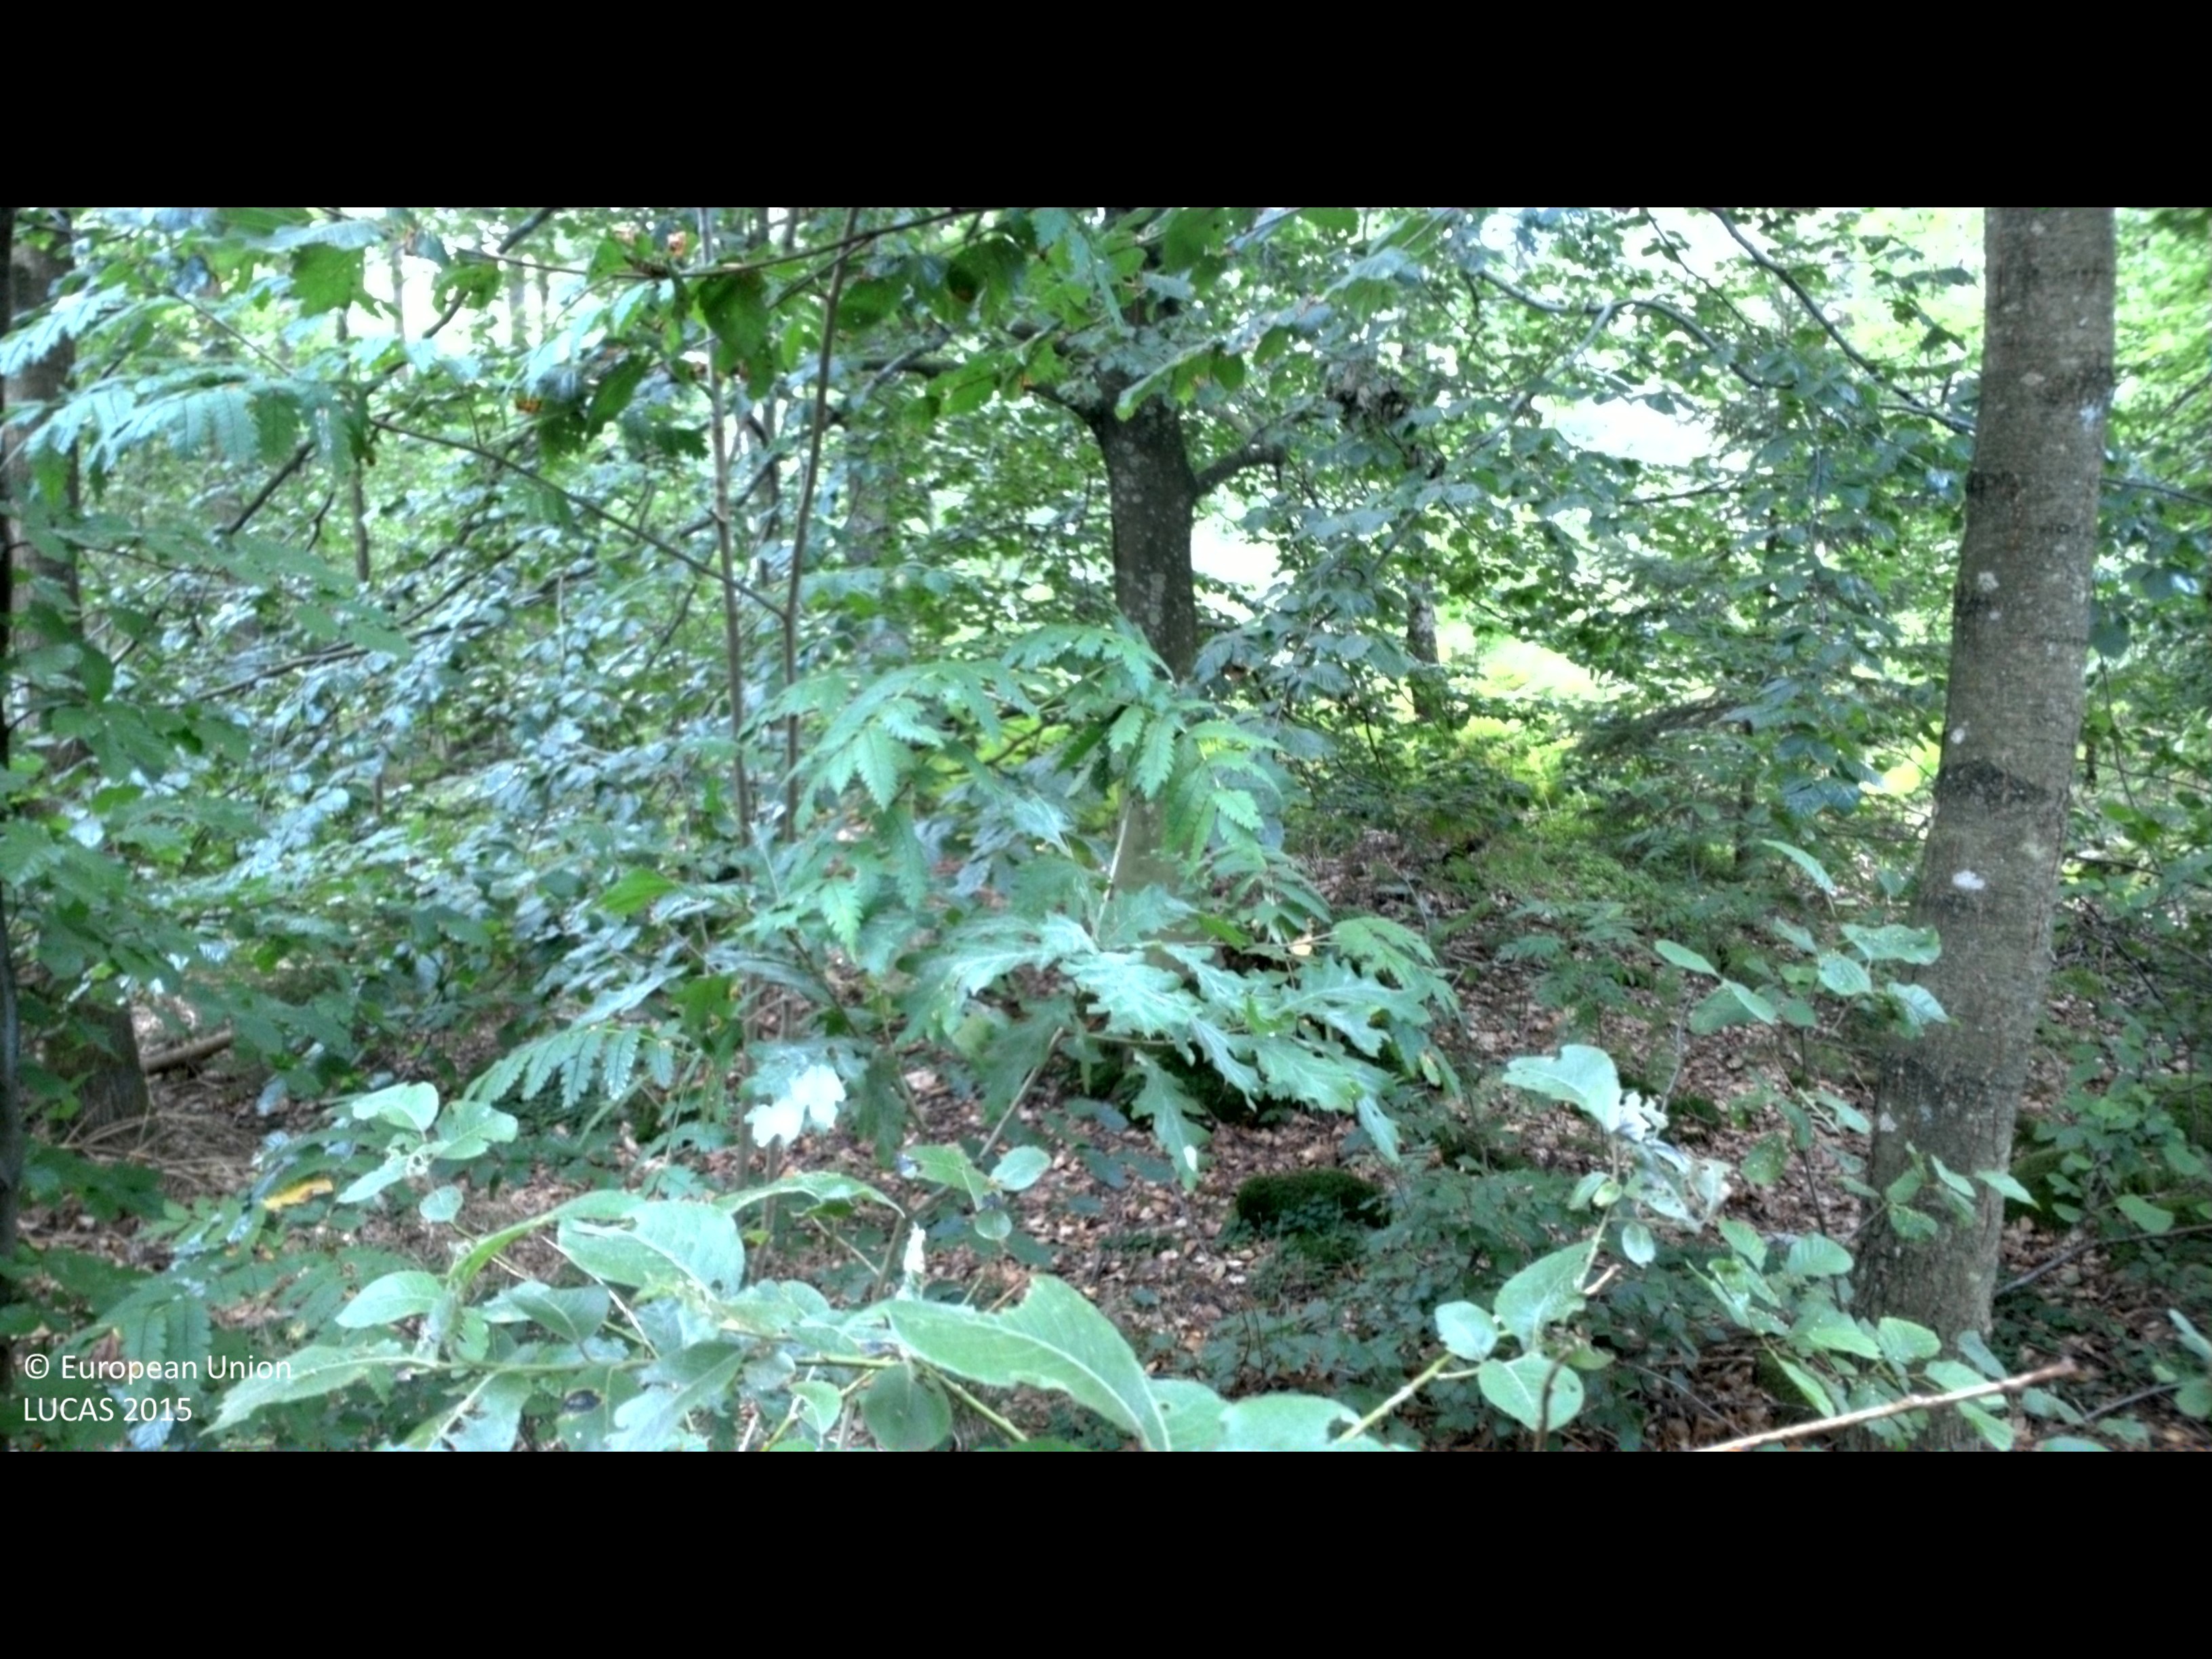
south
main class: Woodland
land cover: Broadleaved woodland
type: mesophytic deciduous forest
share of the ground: > 75 %
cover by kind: broadleaved forest trees 75 %, shrubs 20 %, herbaceous plants 5 %
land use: Residential
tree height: > 5 m
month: September
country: SE
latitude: 56.1419
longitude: 14.5849
